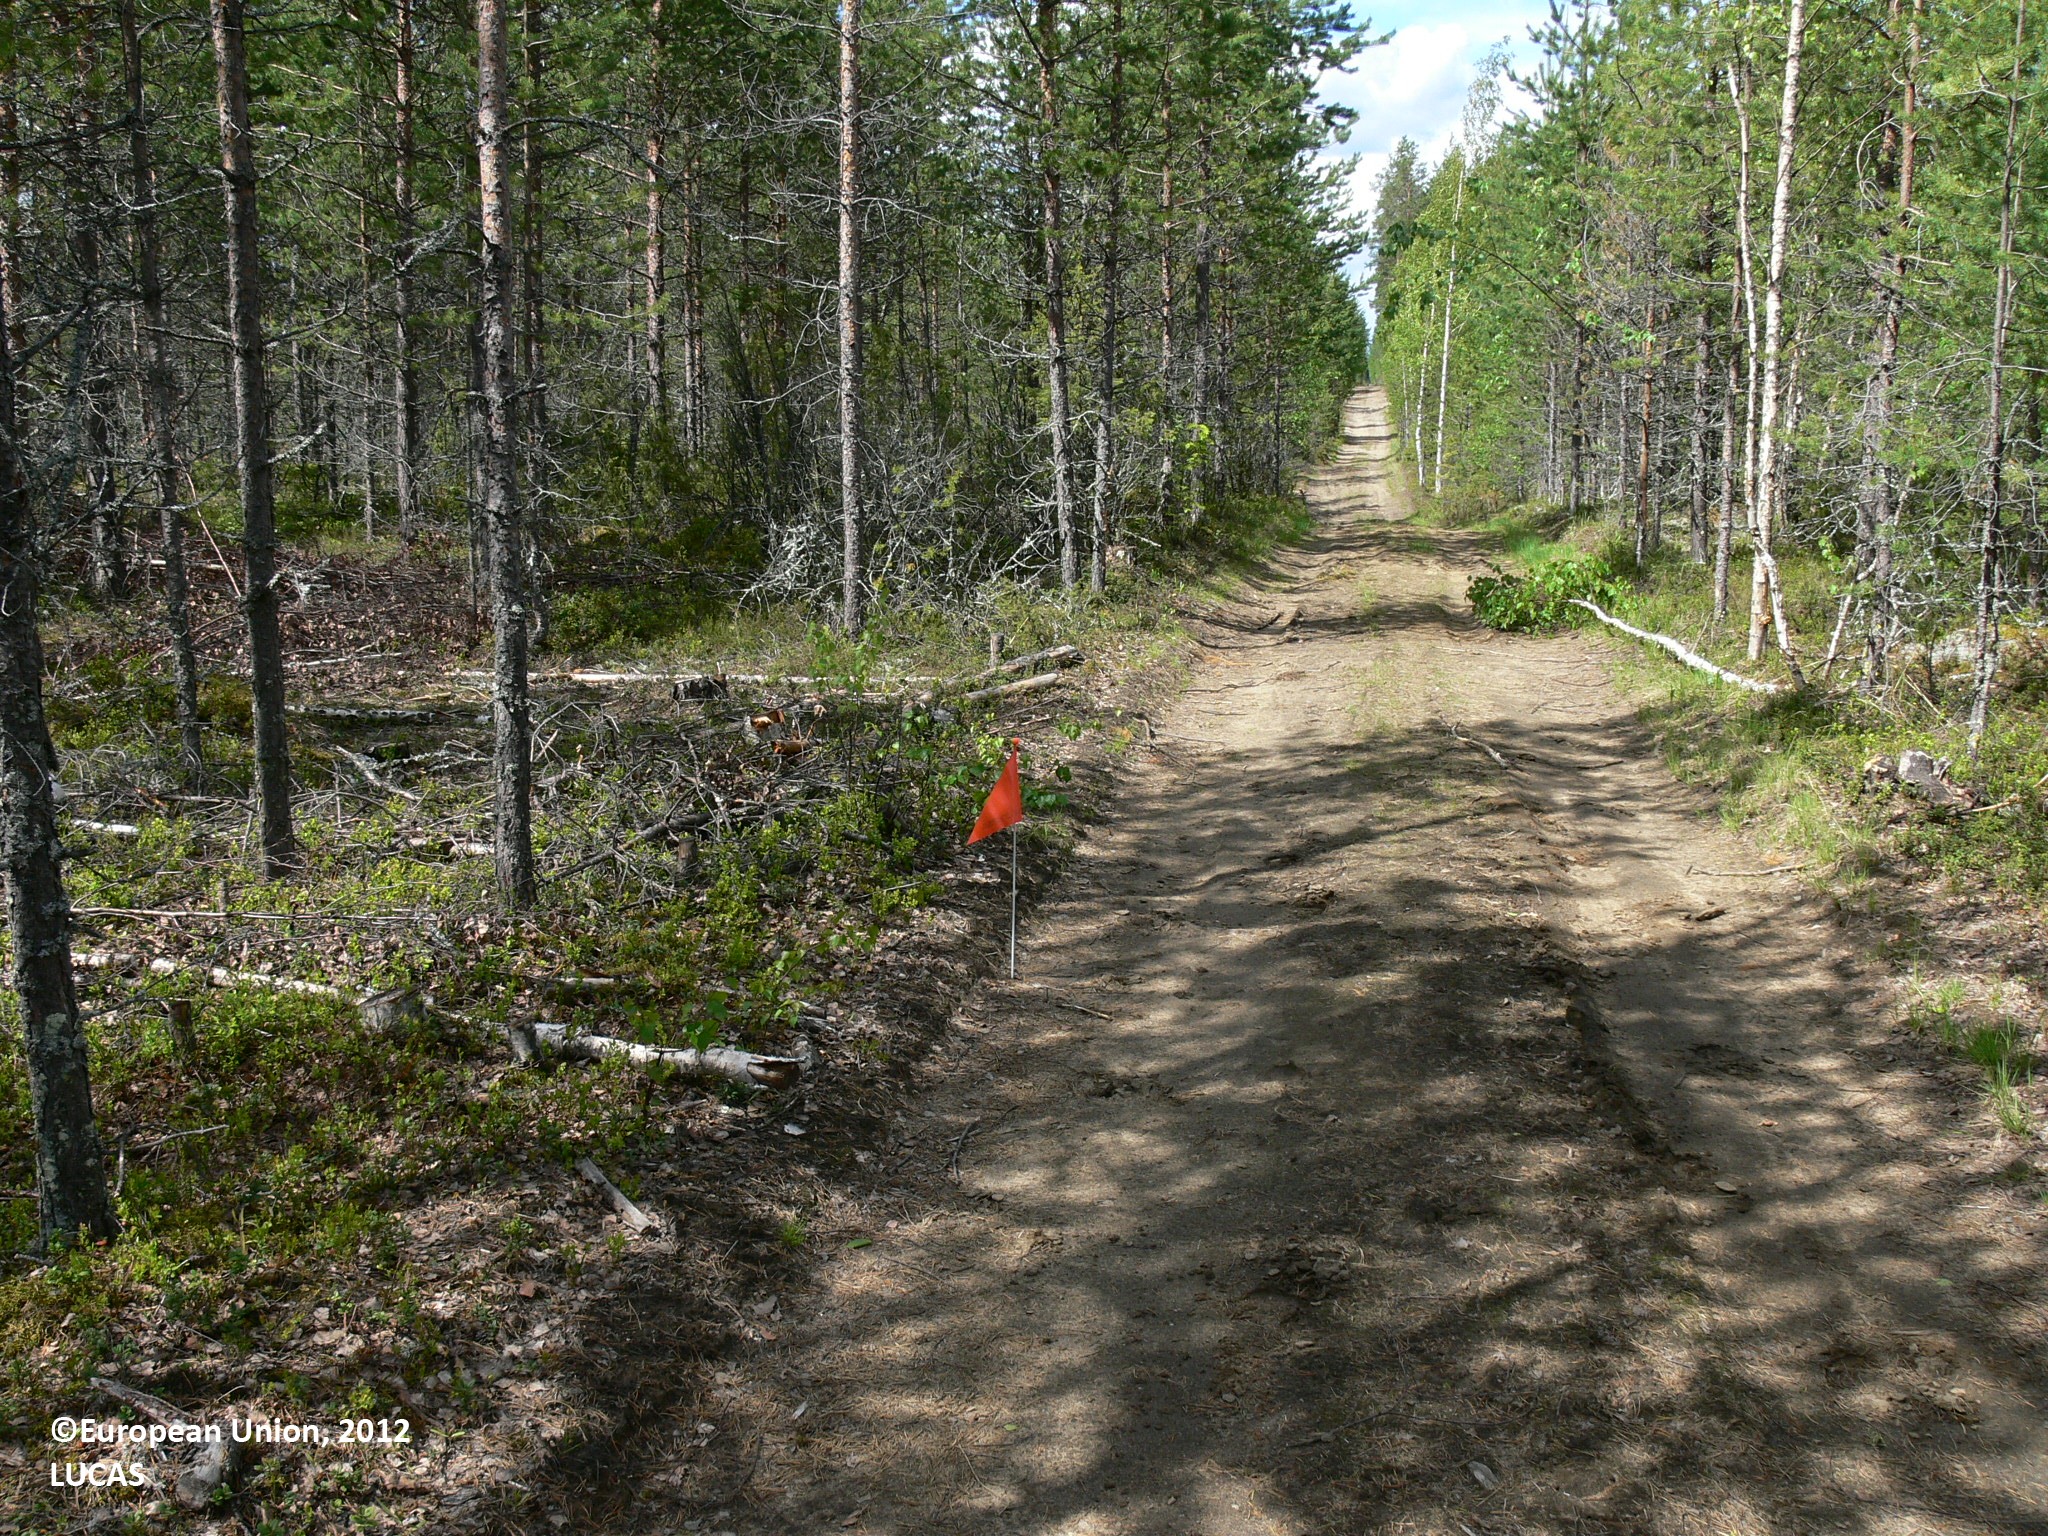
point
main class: Woodland
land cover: Pine dominated mixed woodland
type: boreal forest
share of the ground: > 75 %
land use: Forestry
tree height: < 5 m
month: June
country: FI
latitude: 62.6834
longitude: 29.7611
